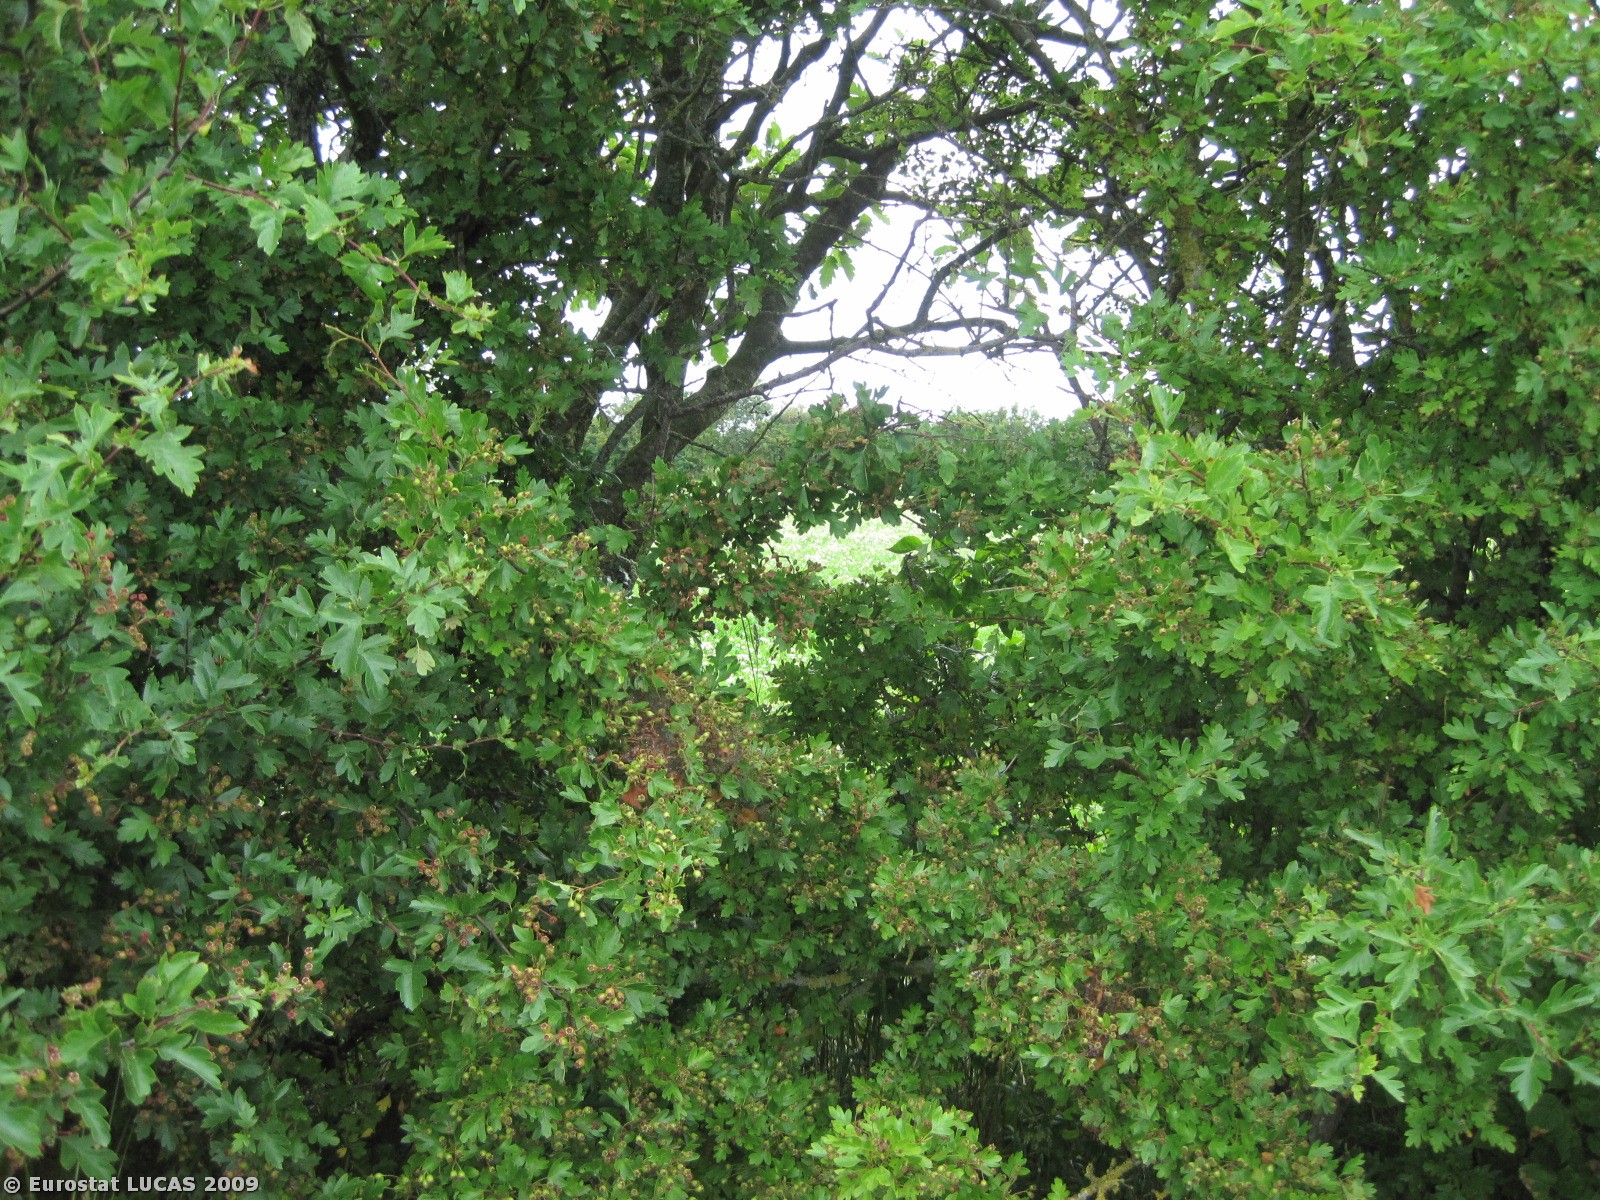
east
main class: Cropland
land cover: Barley
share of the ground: > 75 %
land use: Agriculture (excluding fallow land and kitchen gardens)
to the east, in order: Barley; Grass margins; Broadleaved woodland; Temporary grasslands; Broadleaved woodland; Grass margins; Maize; Grass margins; Paved roads, cycling and walking lanes; Grass margins; Broadleaved woodland; Grass margins; Barley
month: June
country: DK
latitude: 56.3441
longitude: 8.8204
